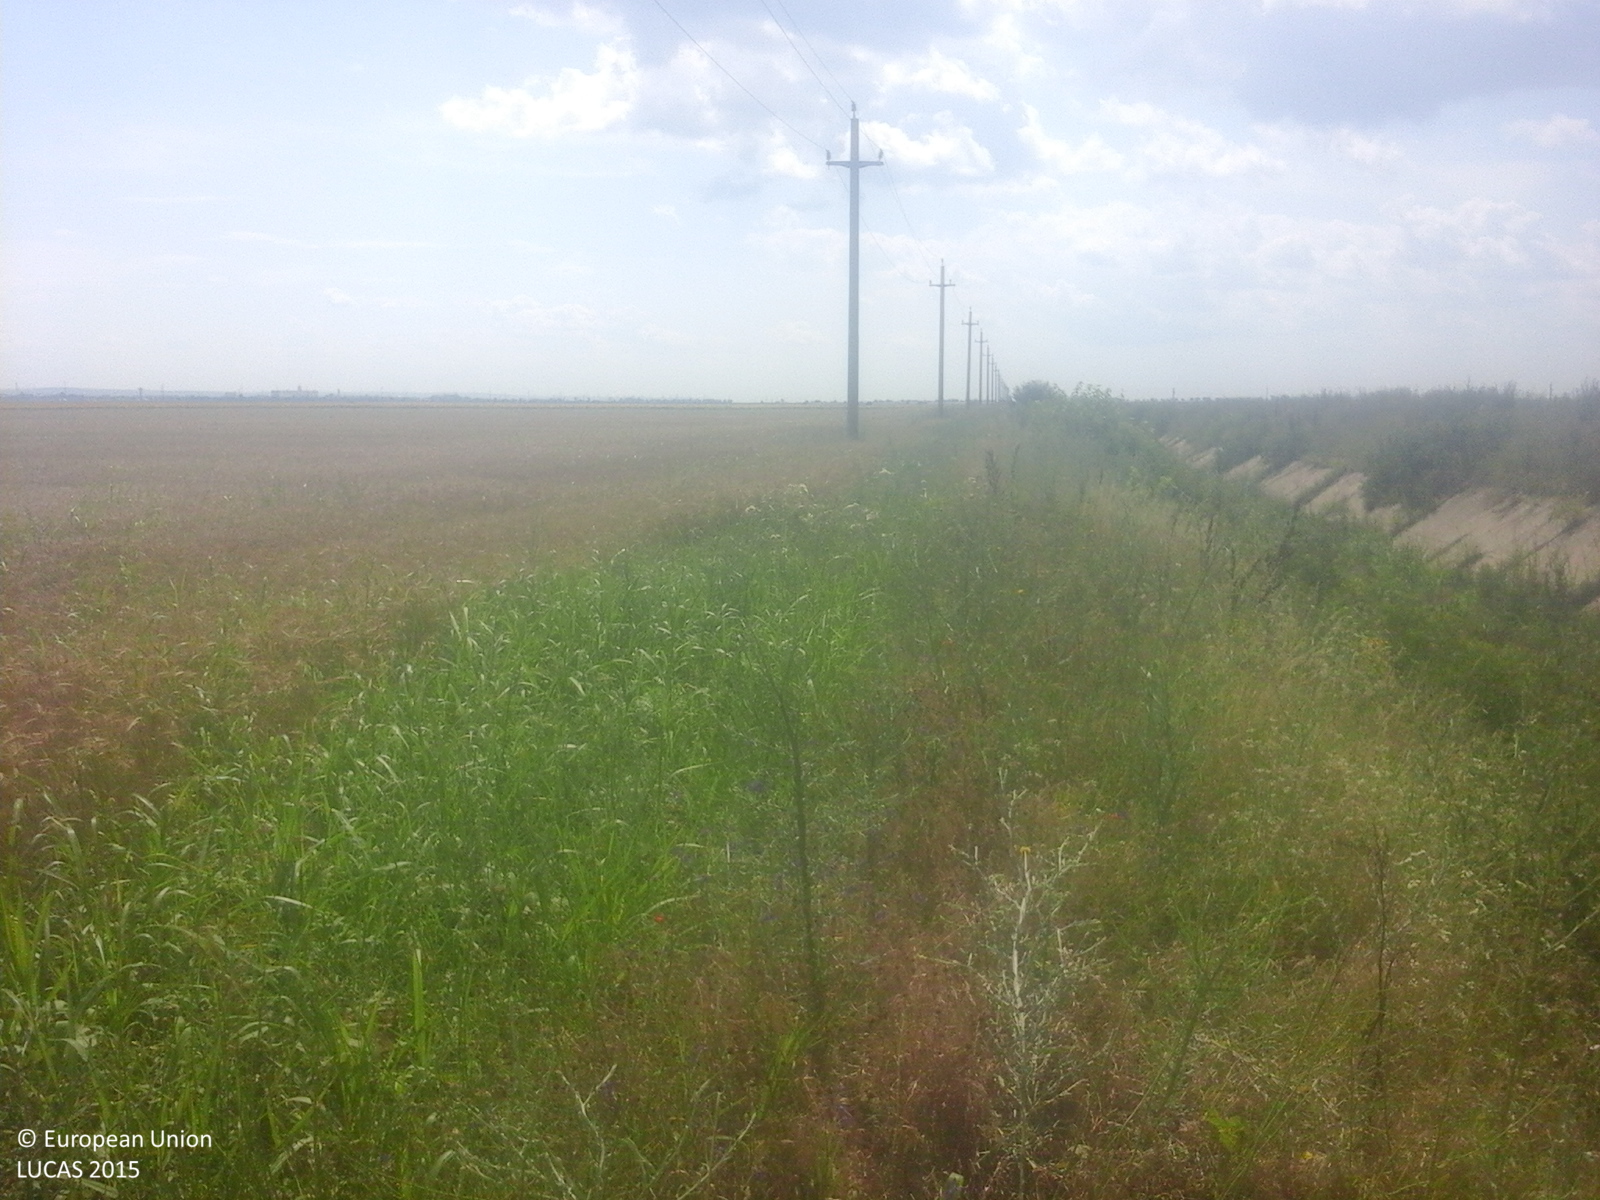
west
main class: Grassland
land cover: Spontaneously vegetated surfaces
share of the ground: > 75 %
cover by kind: herbaceous plants 100 %
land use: Fallow land
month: July
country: RO
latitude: 43.8130
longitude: 24.5488
